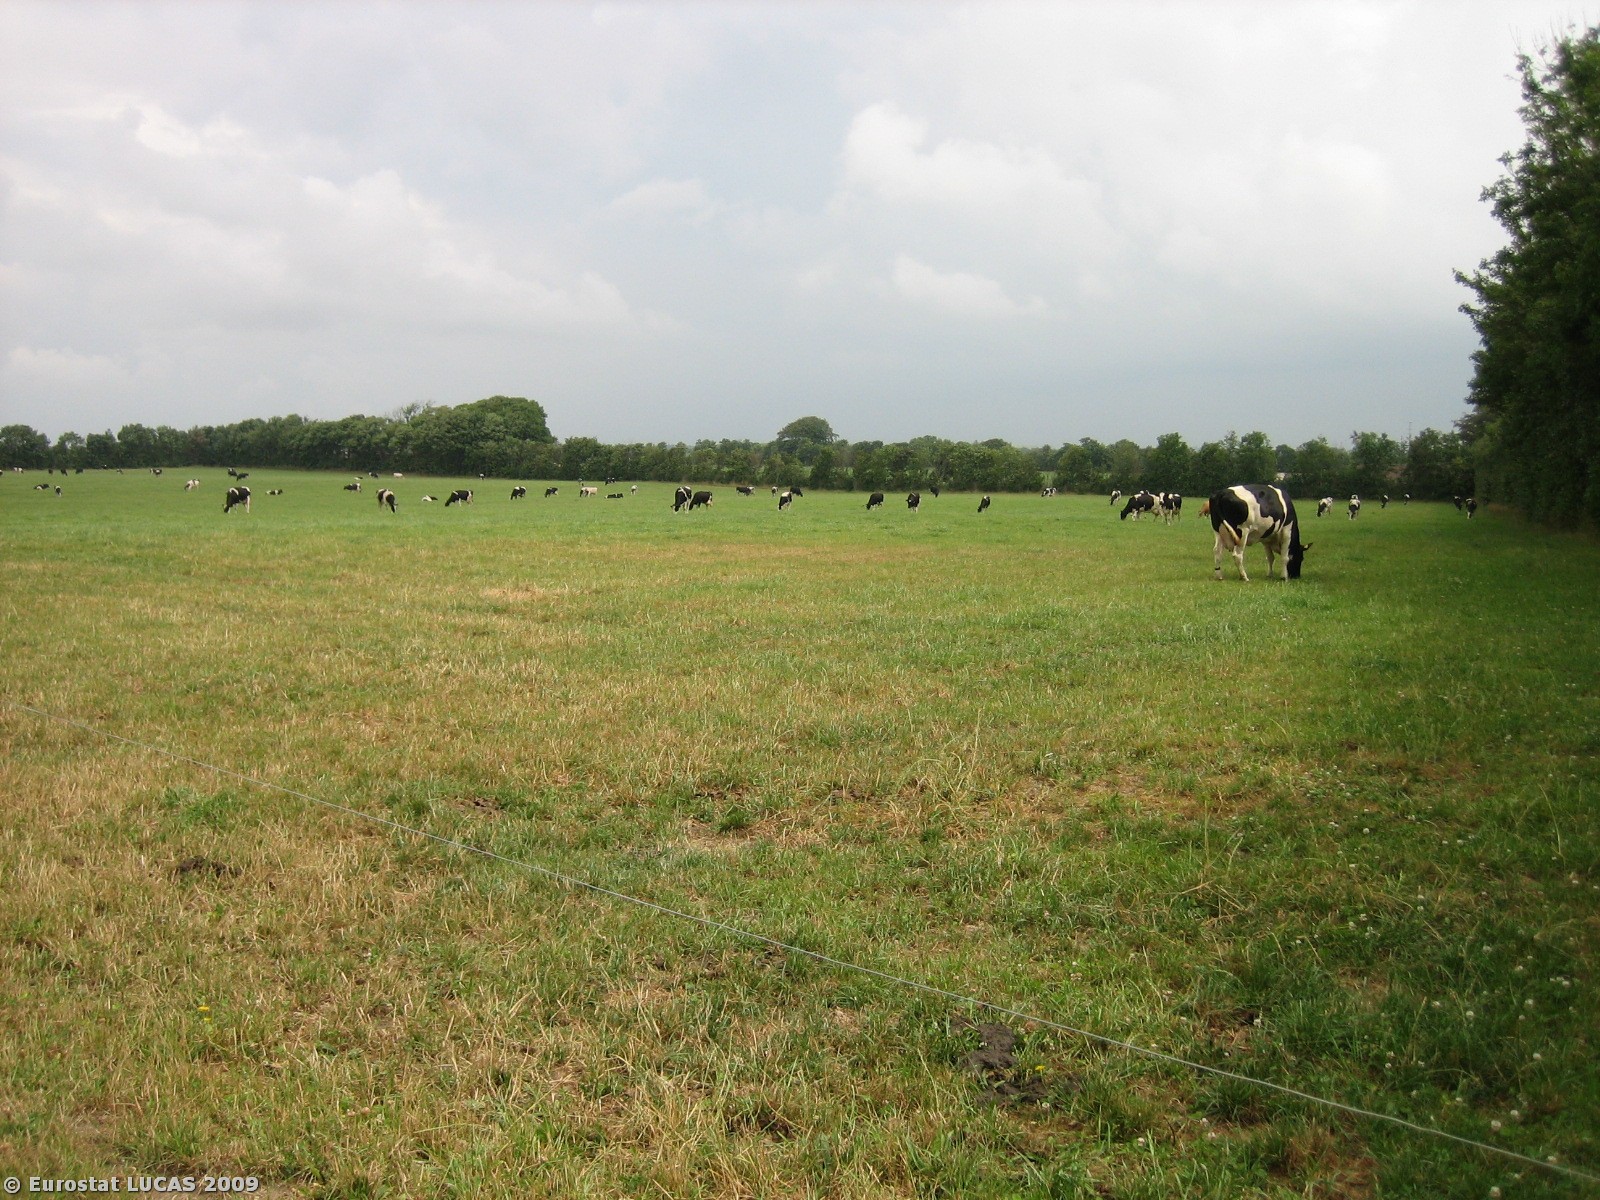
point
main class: Grassland
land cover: Grassland without tree/shrub cover
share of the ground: > 75 %
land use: Agriculture (excluding fallow land and kitchen gardens)
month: July
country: DK
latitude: 55.5884
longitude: 8.7477
